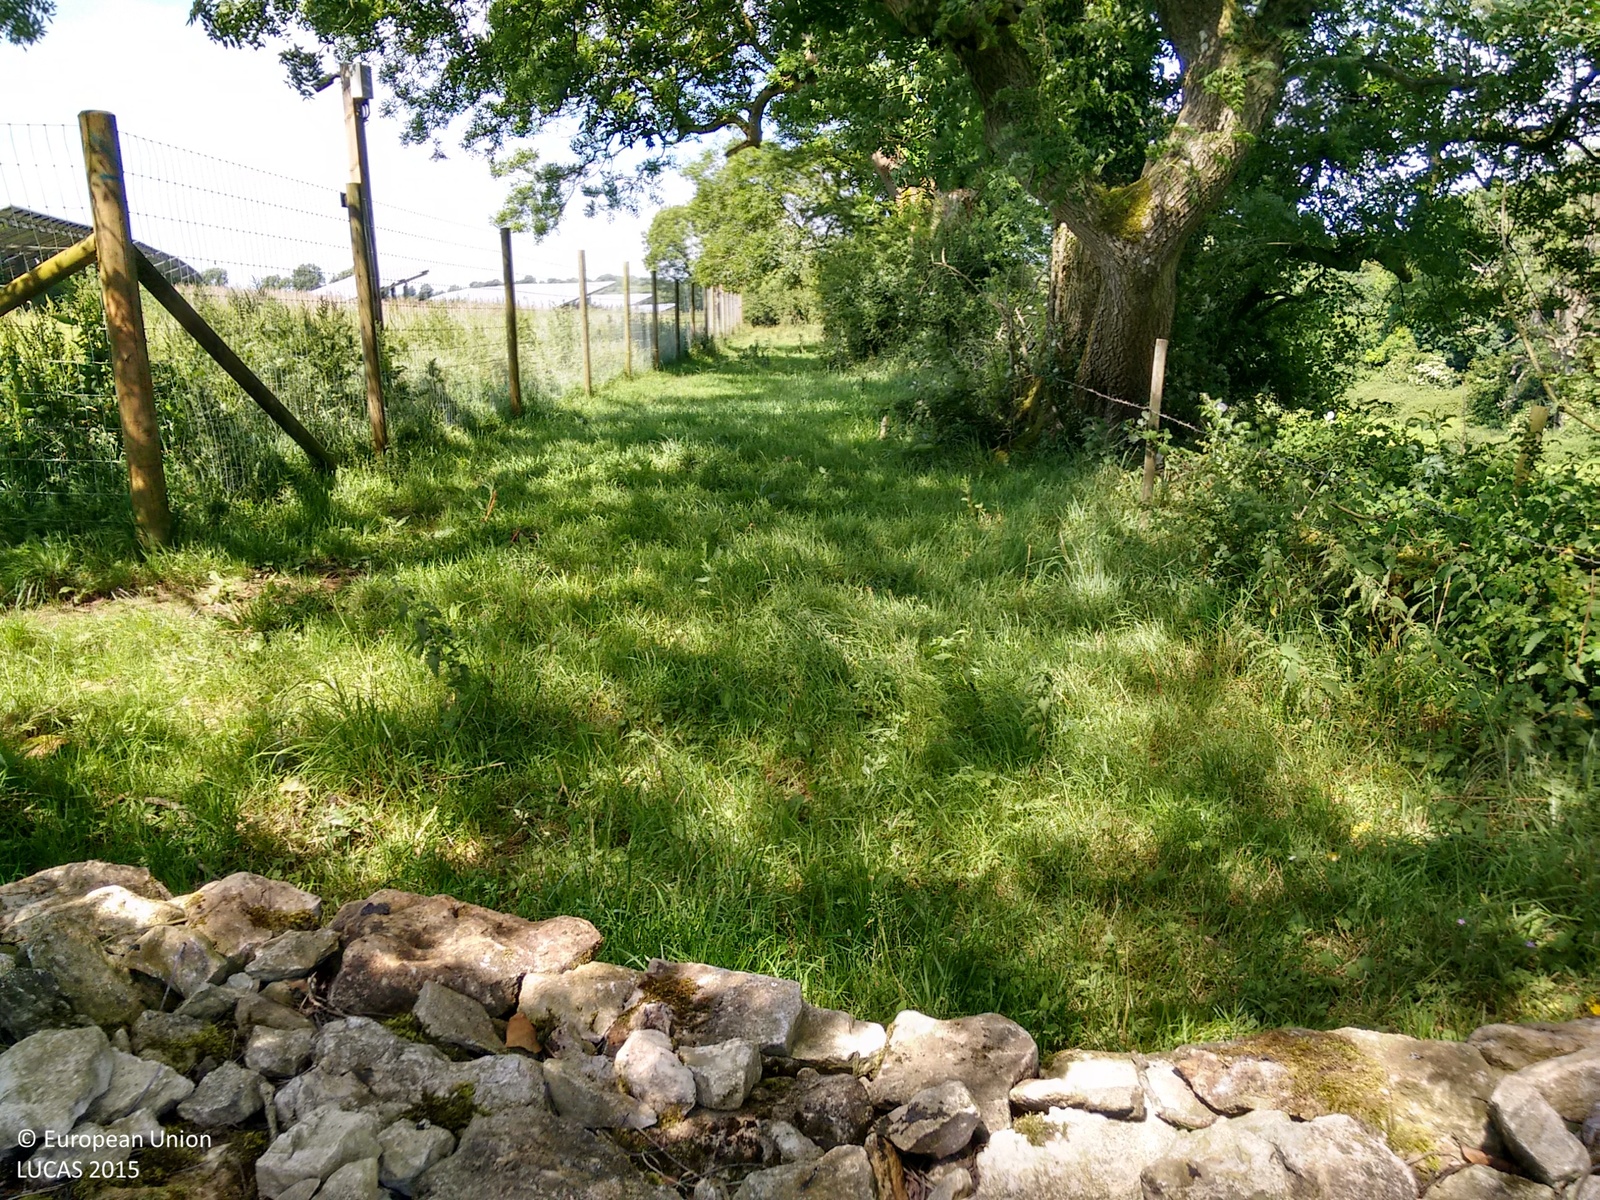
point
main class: Grassland
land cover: Grassland without tree/shrub cover
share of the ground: > 75 %
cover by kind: herbaceous plants 100 %
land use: Energy production
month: July
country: GB
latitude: 51.2004
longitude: -2.5323
